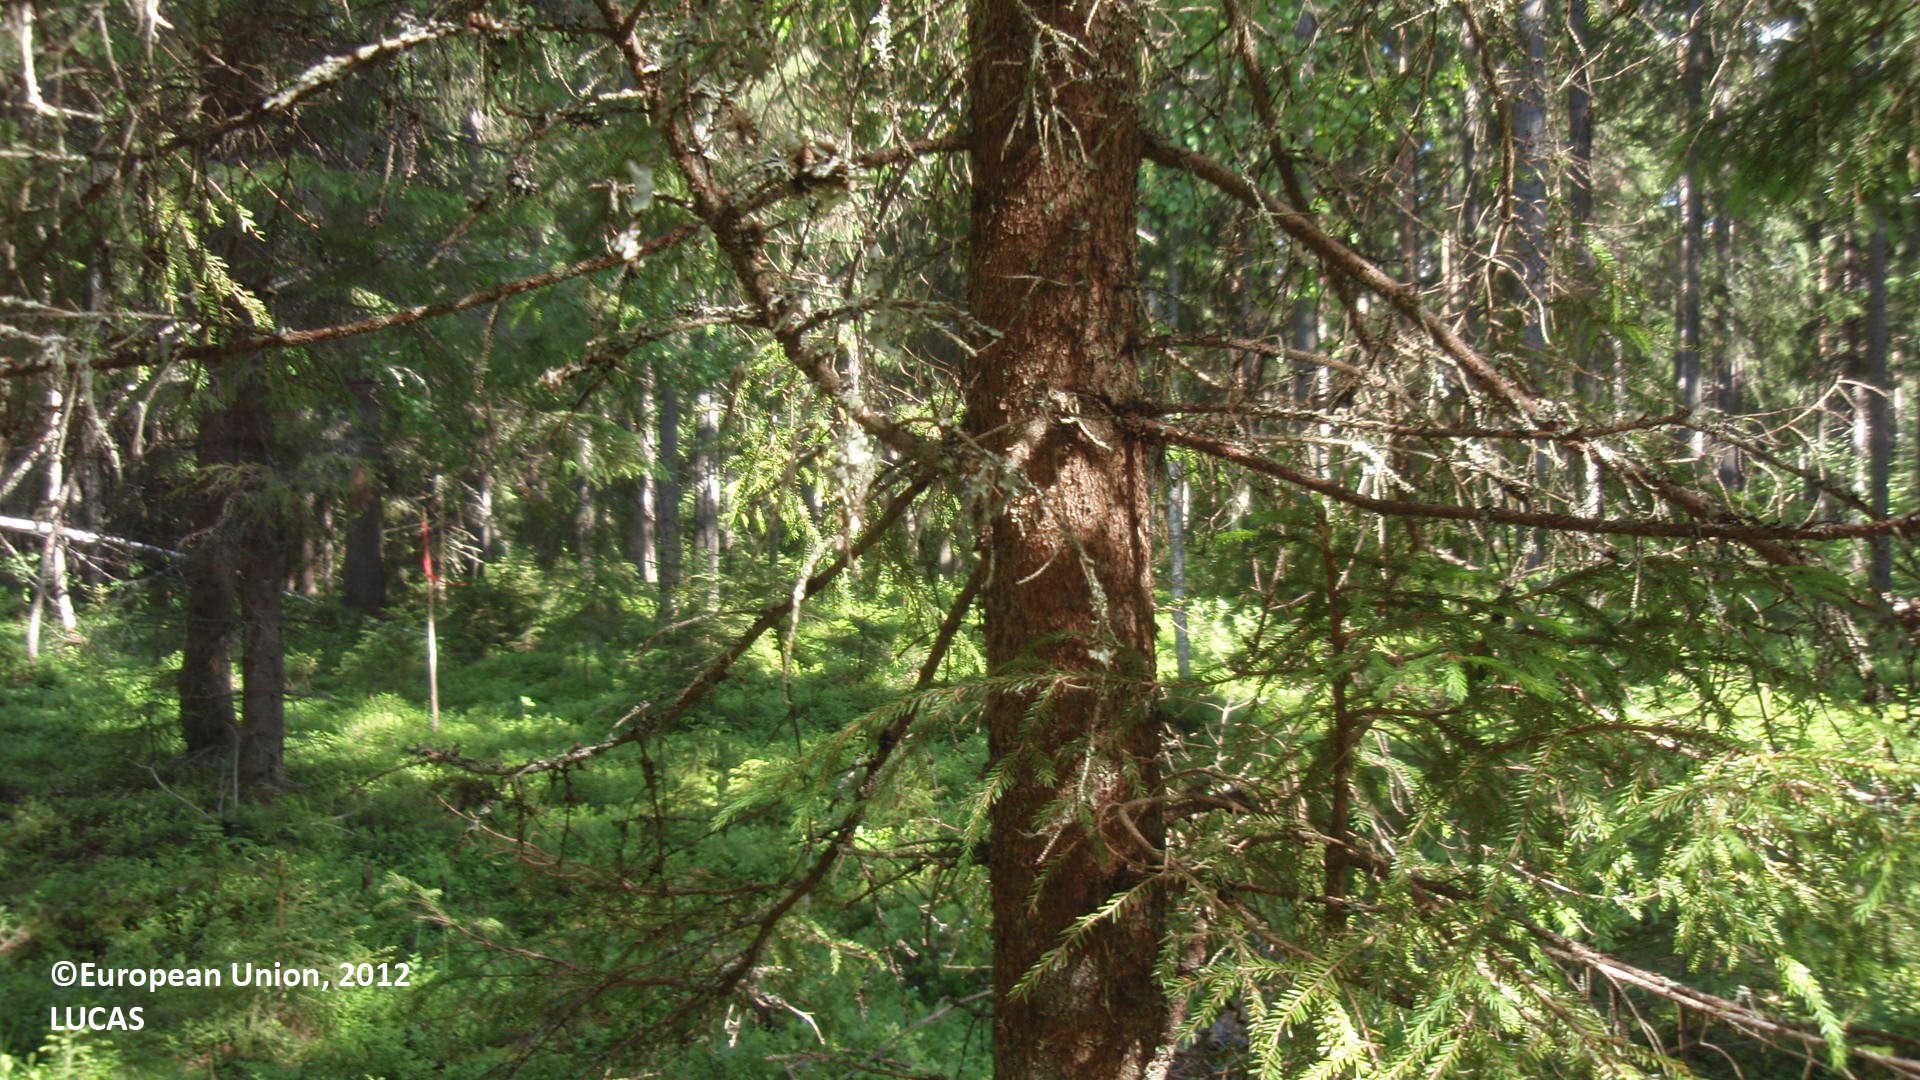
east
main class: Woodland
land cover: Spruce dominated mixed woodland
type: boreal forest
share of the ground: > 75 %
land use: Forestry
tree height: > 5 m
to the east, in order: Spruce dominated mixed woodland; Ditches and canals; Spruce dominated mixed woodland; Pine dominated coniferous woodland; Grass margins; Ditches and canals; Grass margins; Paved roads, cycling and walking lanes; Grass margins; Ditches and canals; Grass margins; Pine dominated coniferous woodland; Spruce dominated mixed woodland
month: June
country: FI
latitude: 61.7416
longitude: 27.0305
